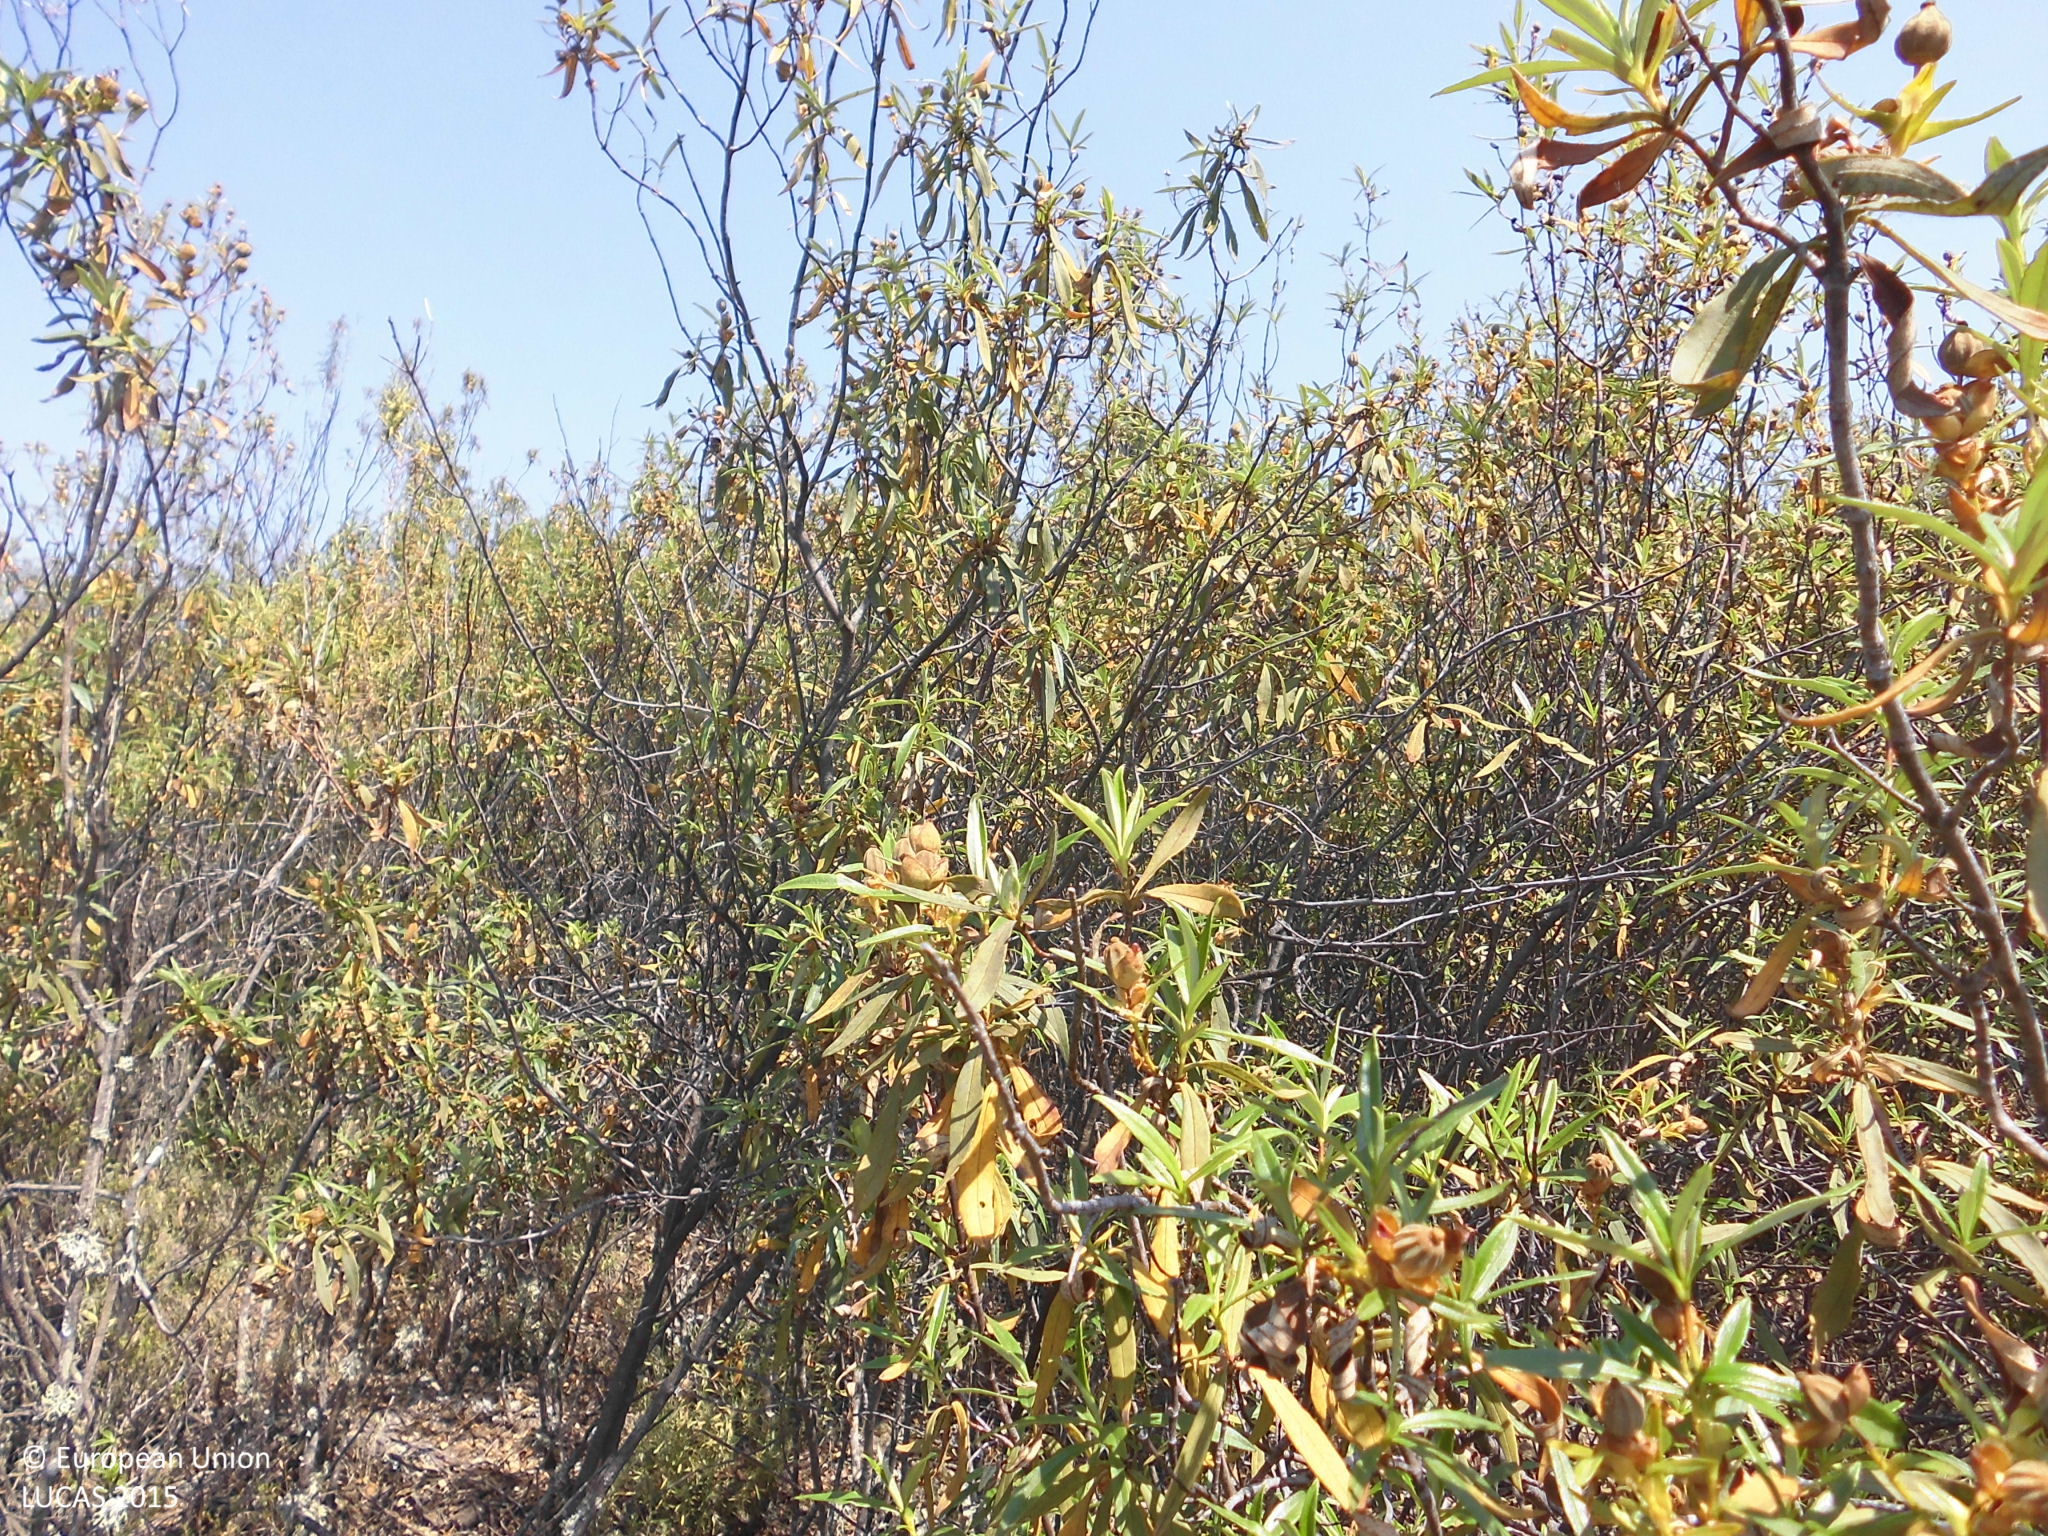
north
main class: Shrubland
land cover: Shrubland without tree cover
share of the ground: > 75 %
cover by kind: shrubs 90 %, herbaceous plants 10 %
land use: Abandoned areas
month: June
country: ES
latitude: 40.0956
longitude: -5.4855
